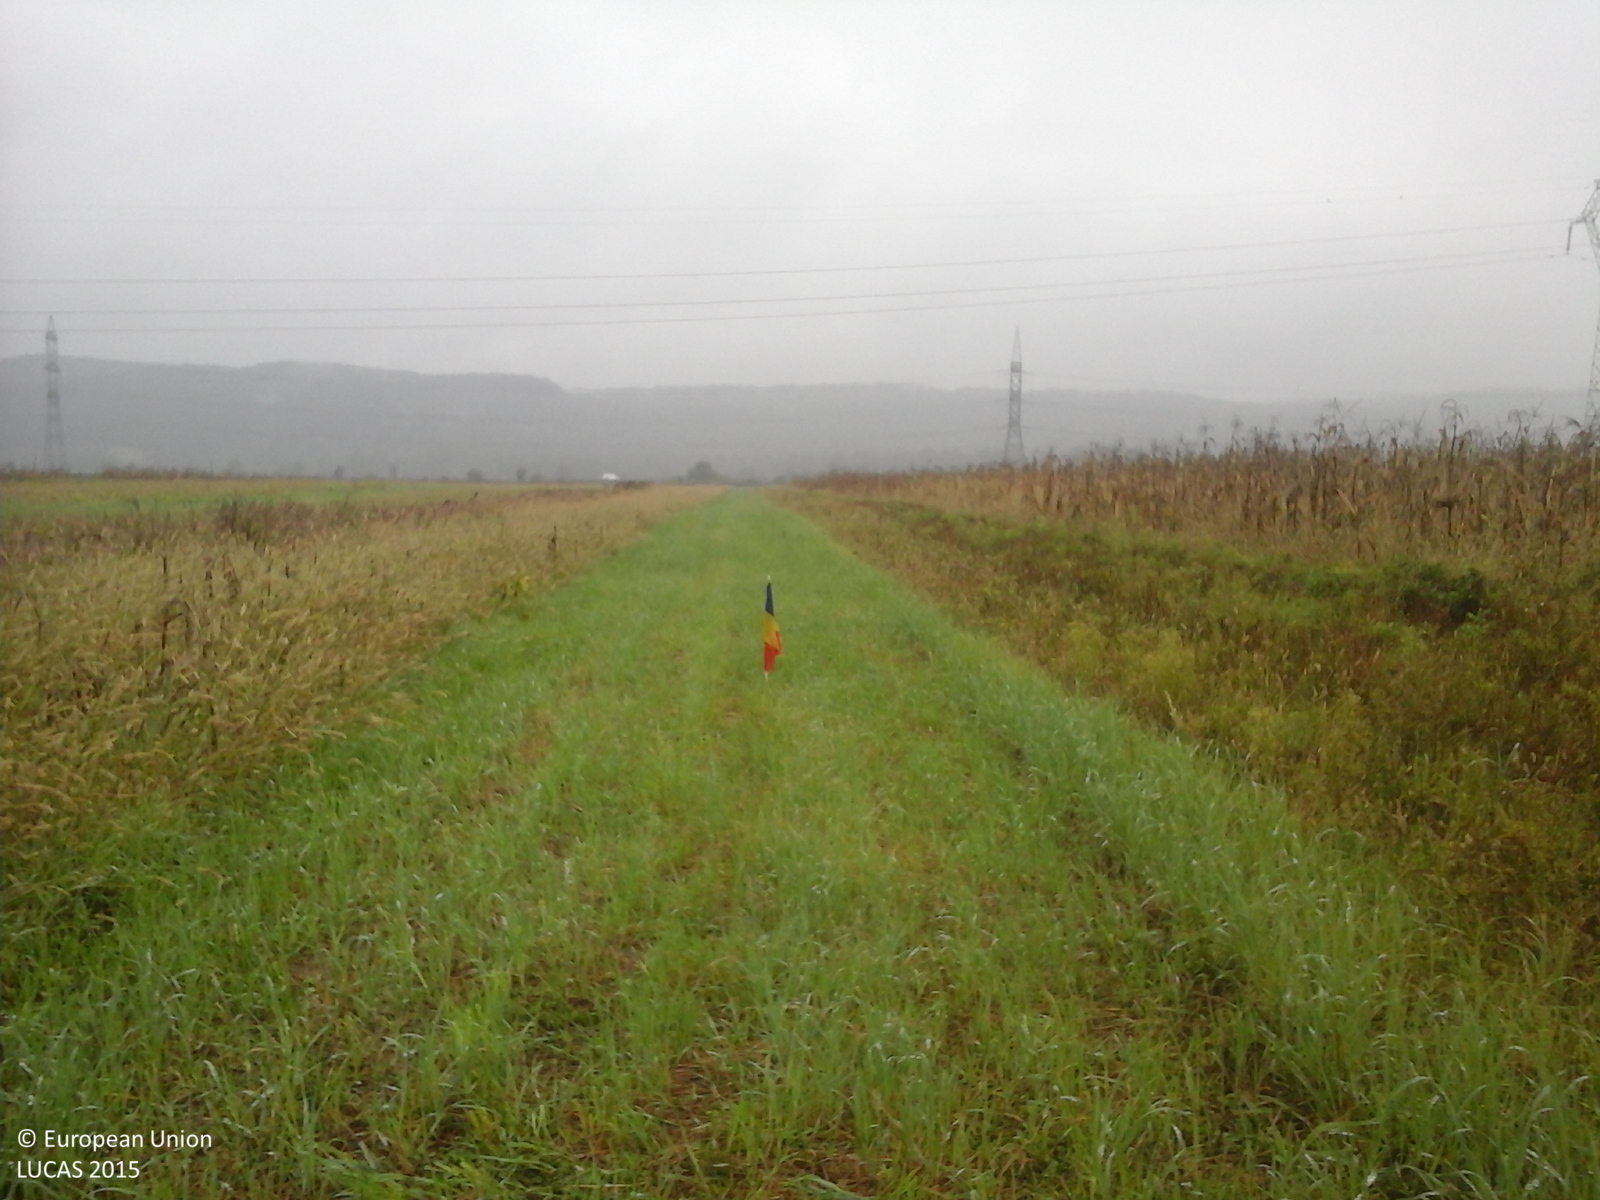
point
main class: Grassland
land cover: Grassland without tree/shrub cover
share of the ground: > 75 %
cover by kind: herbaceous plants 100 %
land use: Agriculture (excluding fallow land and kitchen gardens)
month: September
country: RO
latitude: 44.9217
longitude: 23.5238
